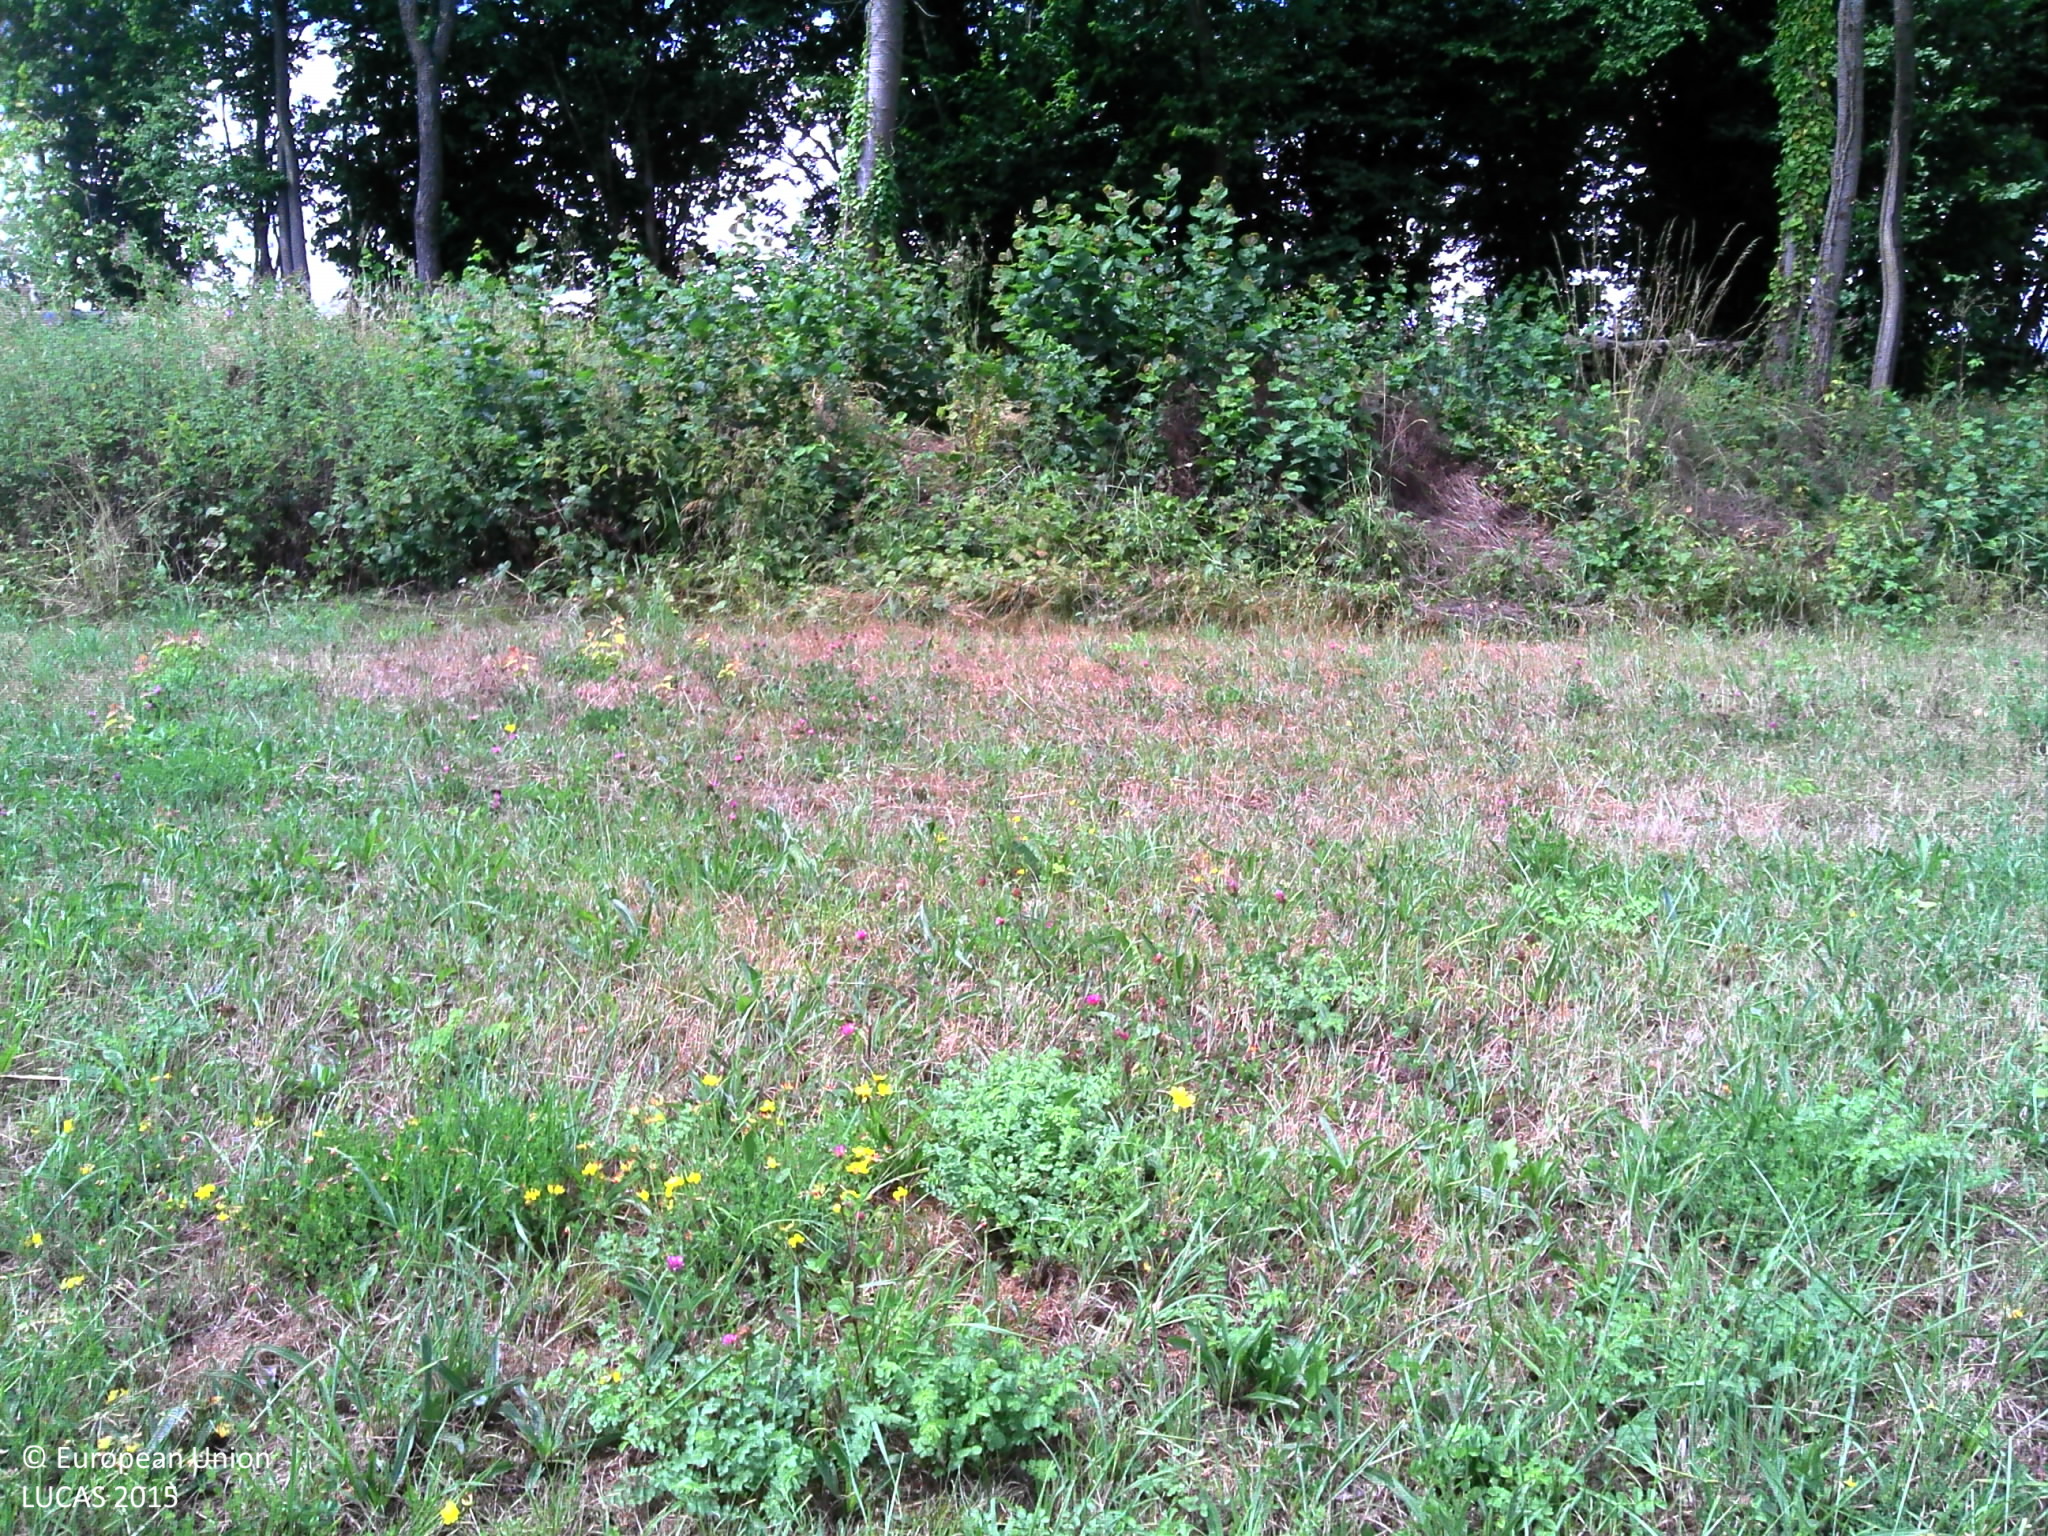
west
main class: Grassland
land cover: Grassland without tree/shrub cover
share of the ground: > 75 %
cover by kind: herbaceous plants 100 %
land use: Agriculture (excluding fallow land and kitchen gardens)
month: July
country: BE
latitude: 49.5650
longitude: 5.7542
